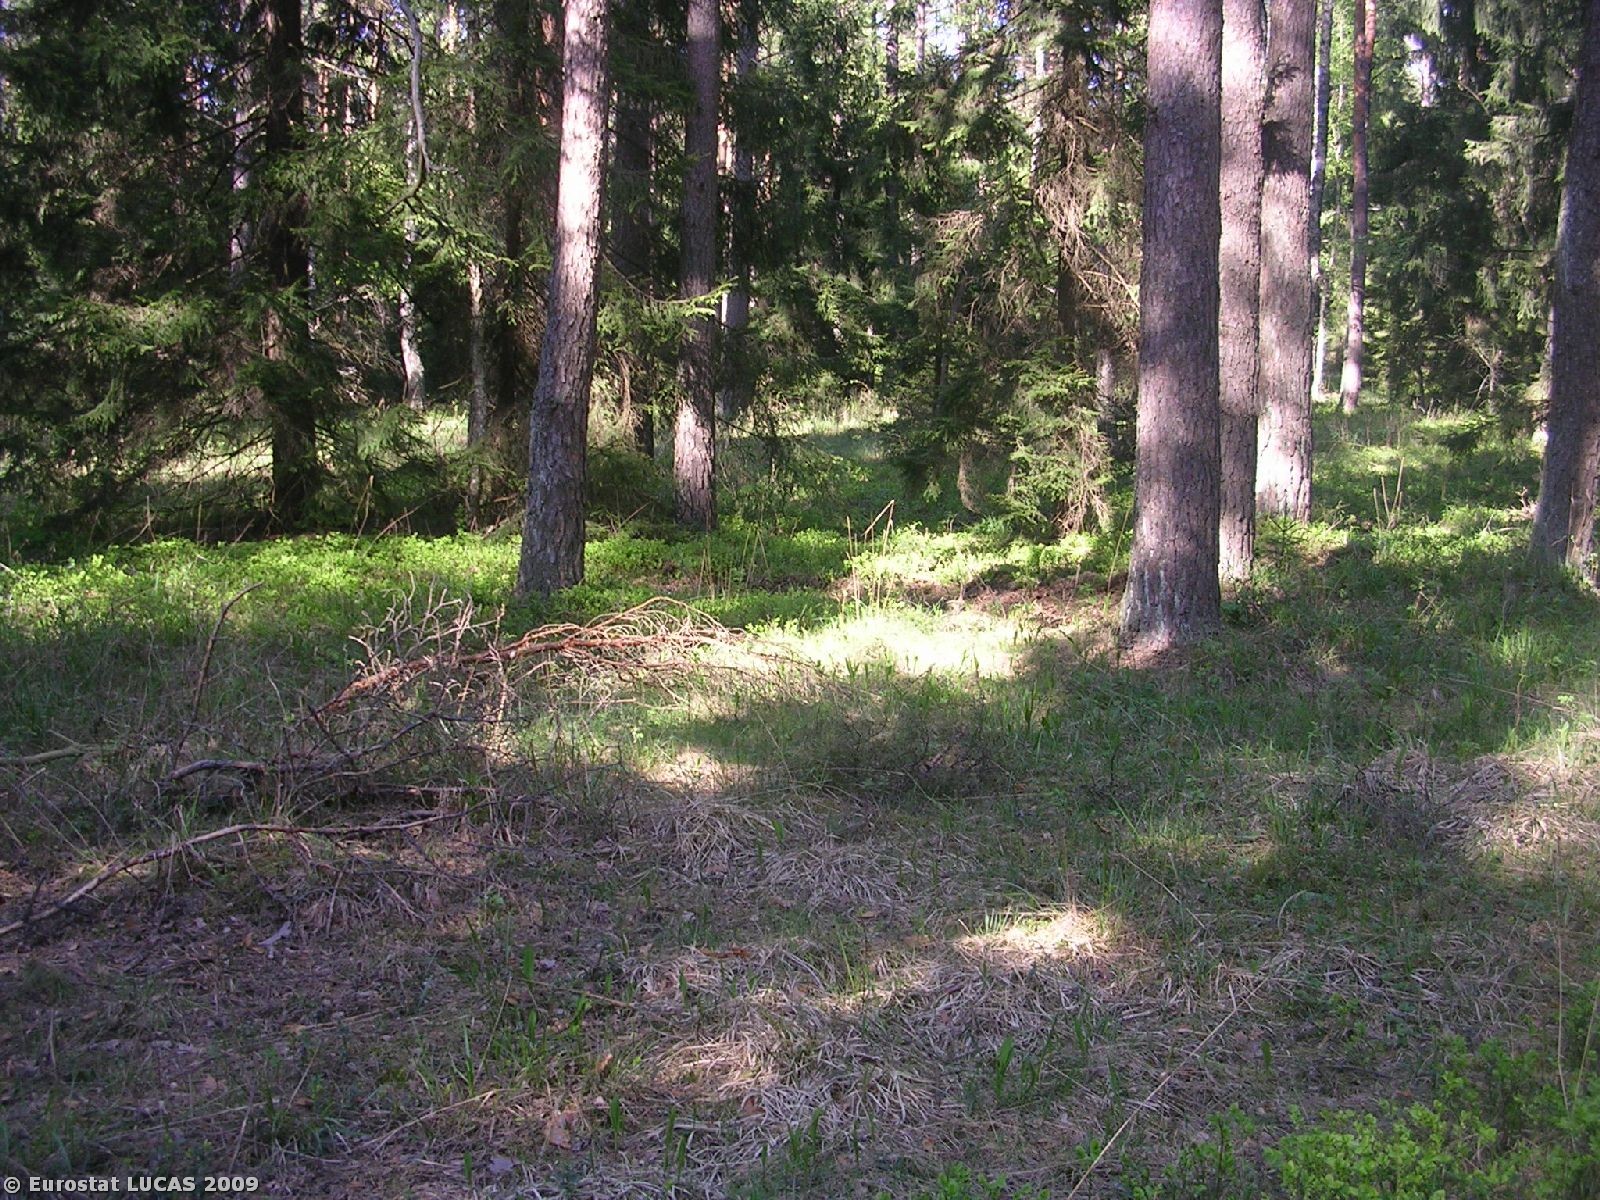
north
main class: Woodland
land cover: Mixed woodland
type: hemiboreal forest and nemoral coniferous forest and mixed broadleaved-coniferous forest
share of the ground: 50 - 75 %
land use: Forestry
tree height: > 5 m
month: May
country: PL
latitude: 53.1338
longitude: 23.3387
